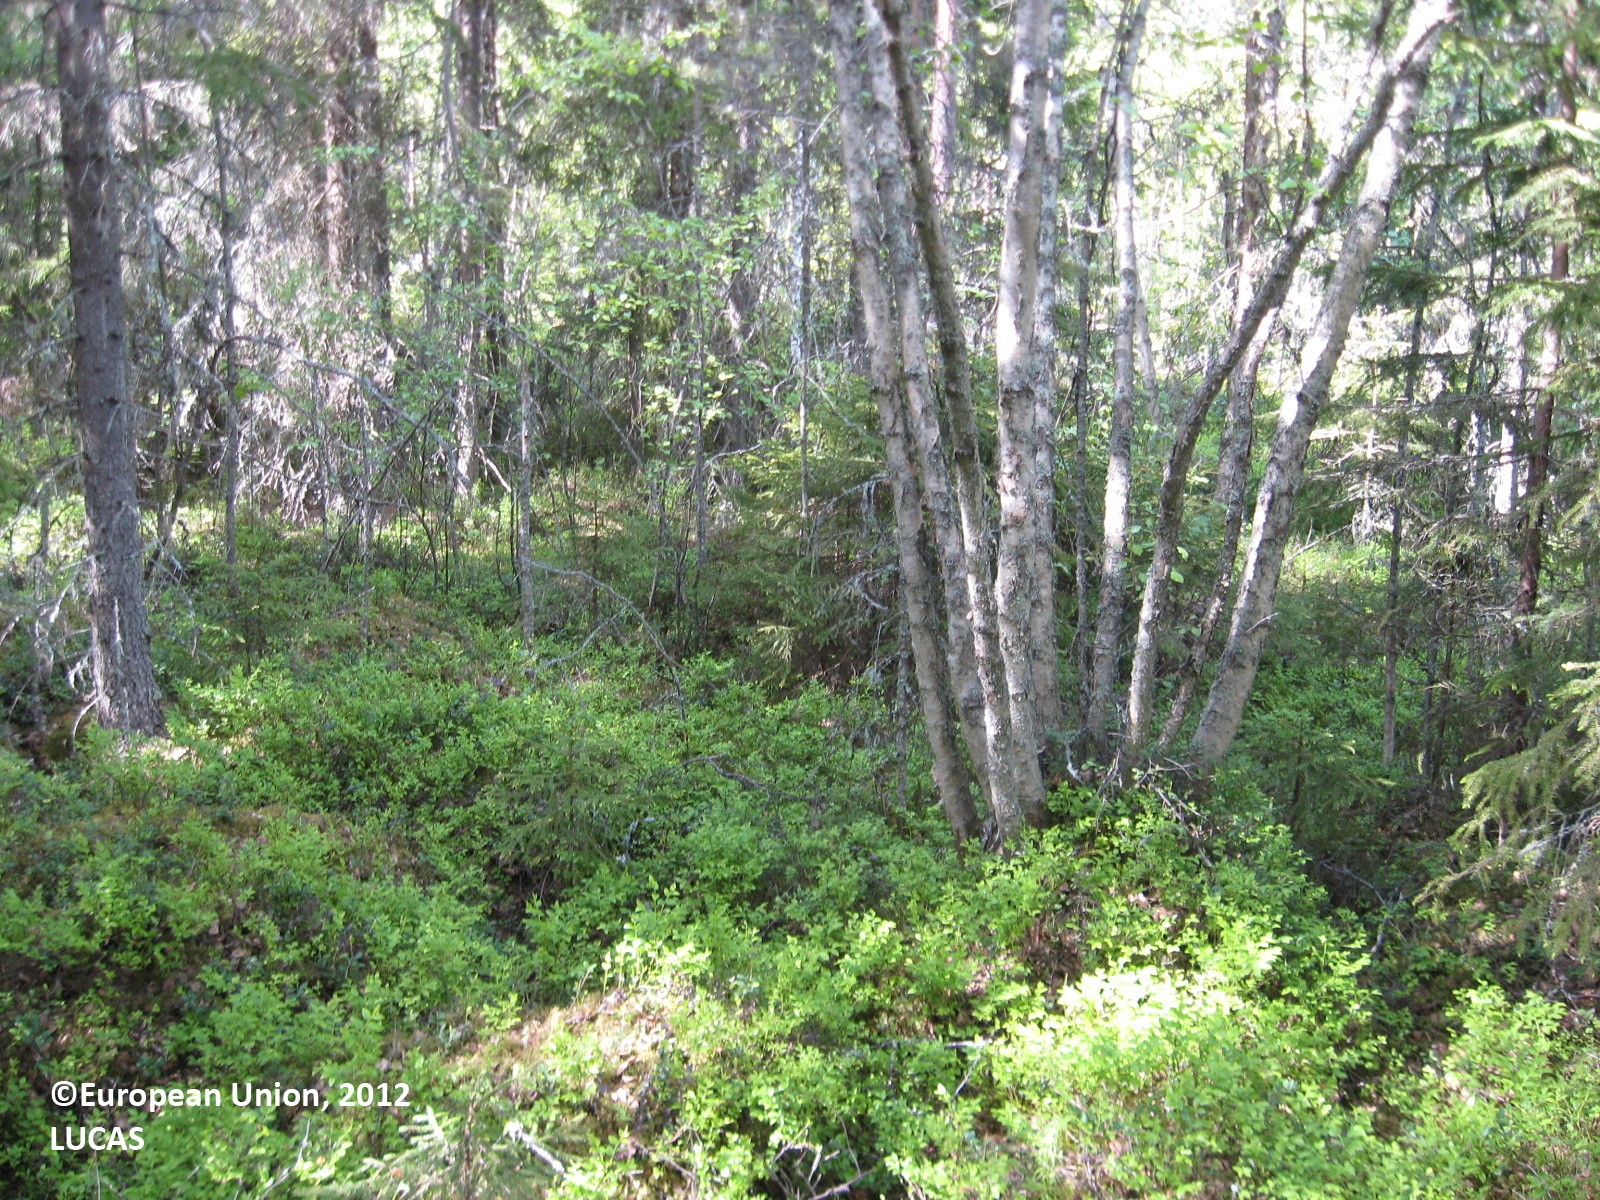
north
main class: Woodland
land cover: Spruce dominated mixed woodland
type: boreal forest
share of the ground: > 75 %
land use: Forestry
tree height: > 5 m
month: June
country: FI
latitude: 63.2157
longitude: 21.9171
